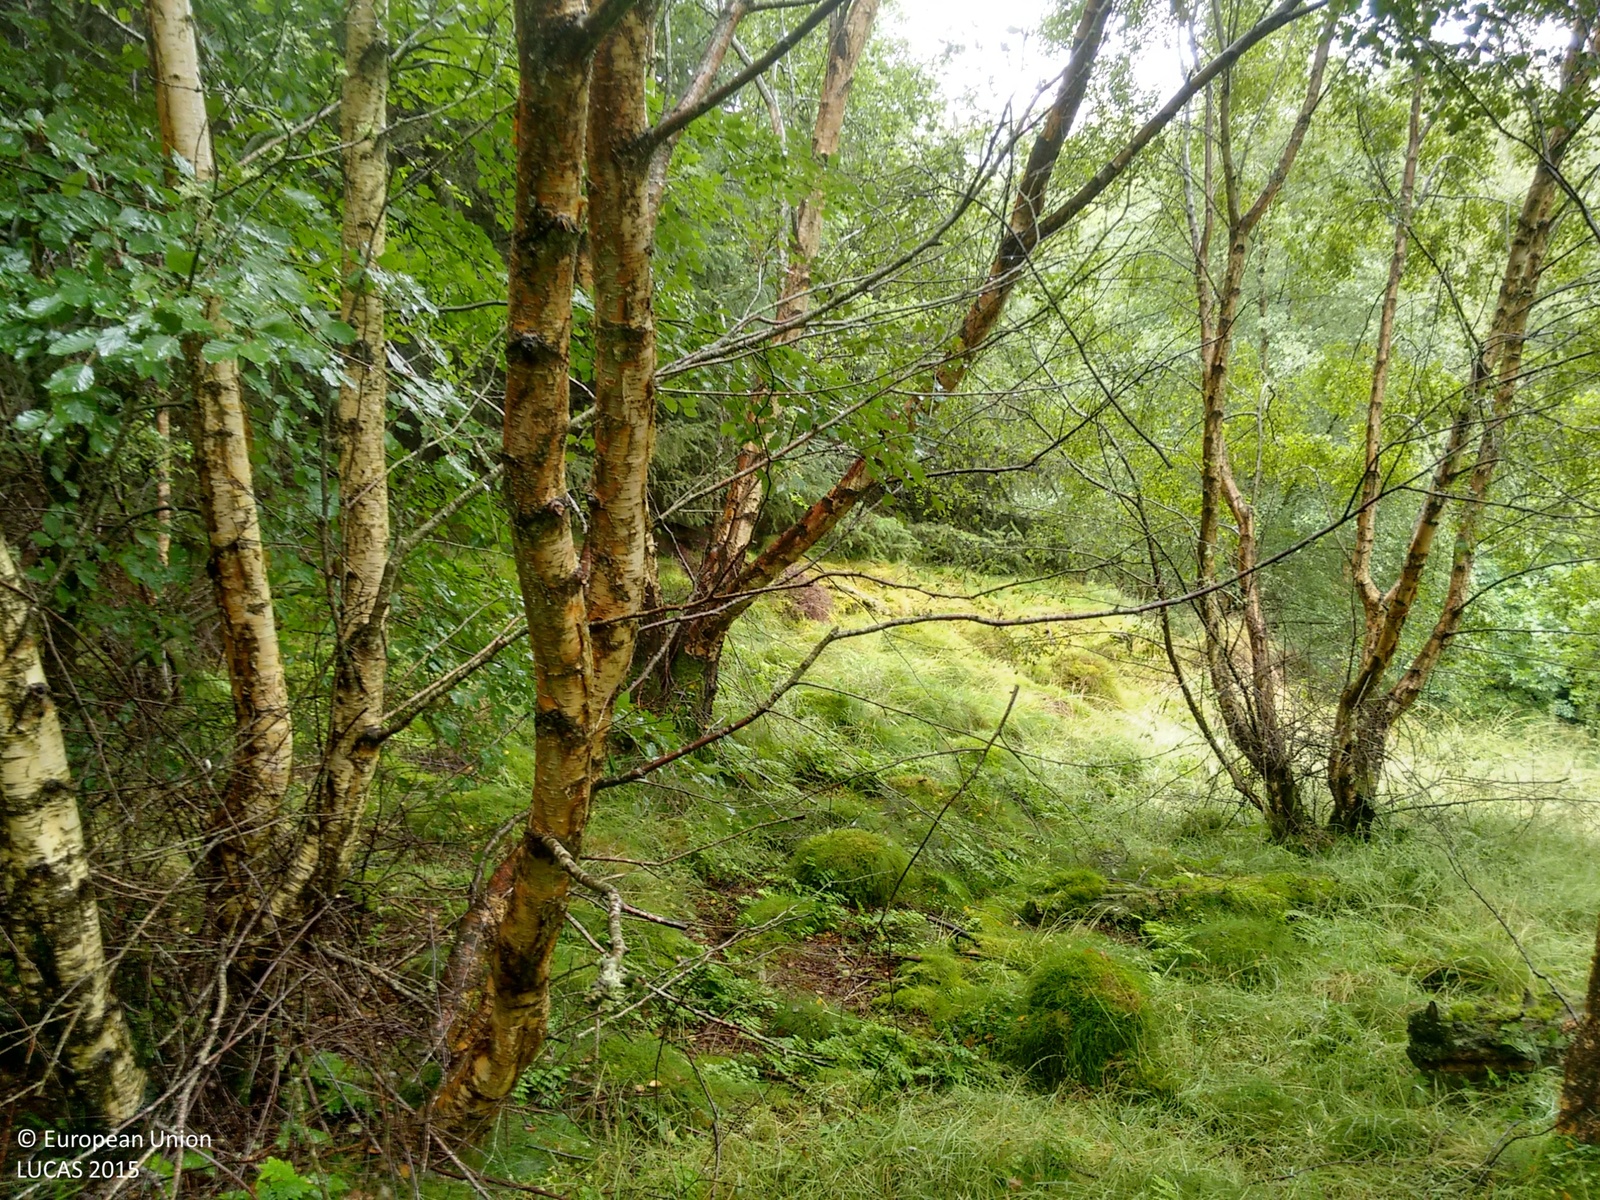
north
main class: Woodland
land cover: Spruce dominated mixed woodland
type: exotic forest
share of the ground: > 75 %
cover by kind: coniferous forest trees 60 %, broadleaved forest trees 35 %, herbaceous plants 5 %
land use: Forestry
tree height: > 5 m
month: August
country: GB
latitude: 57.4369
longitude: -2.2599
